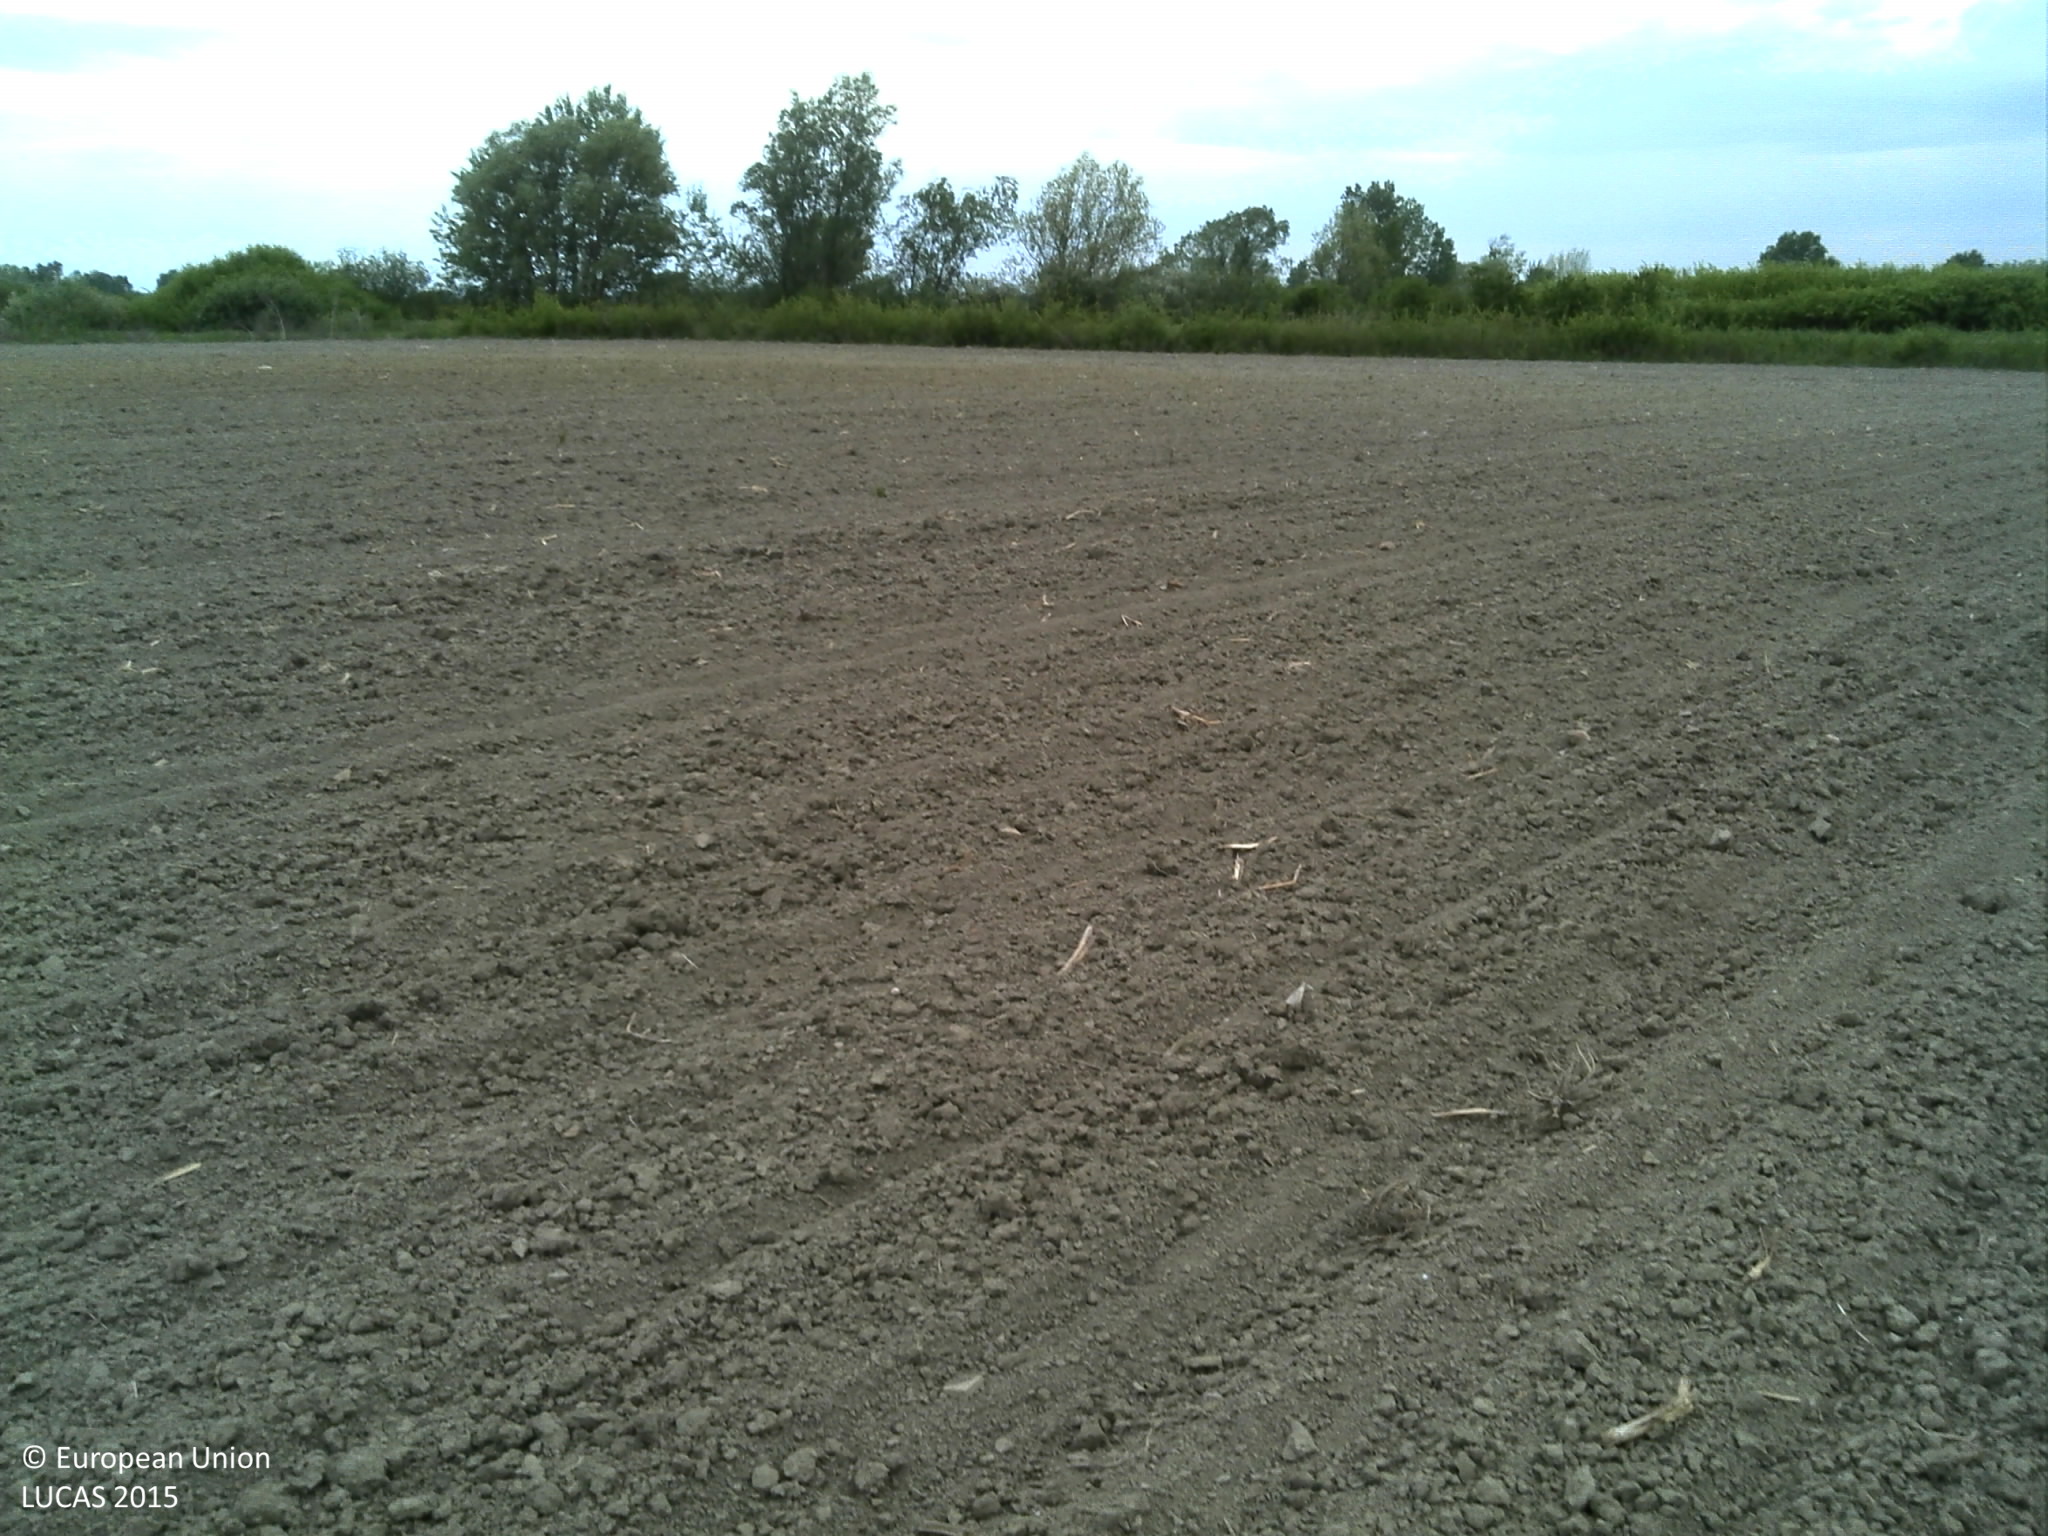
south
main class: Cropland
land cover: Soya
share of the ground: < 10 %
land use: Agriculture (excluding fallow land and kitchen gardens)
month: April
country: HR
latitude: 44.9388
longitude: 18.9915
